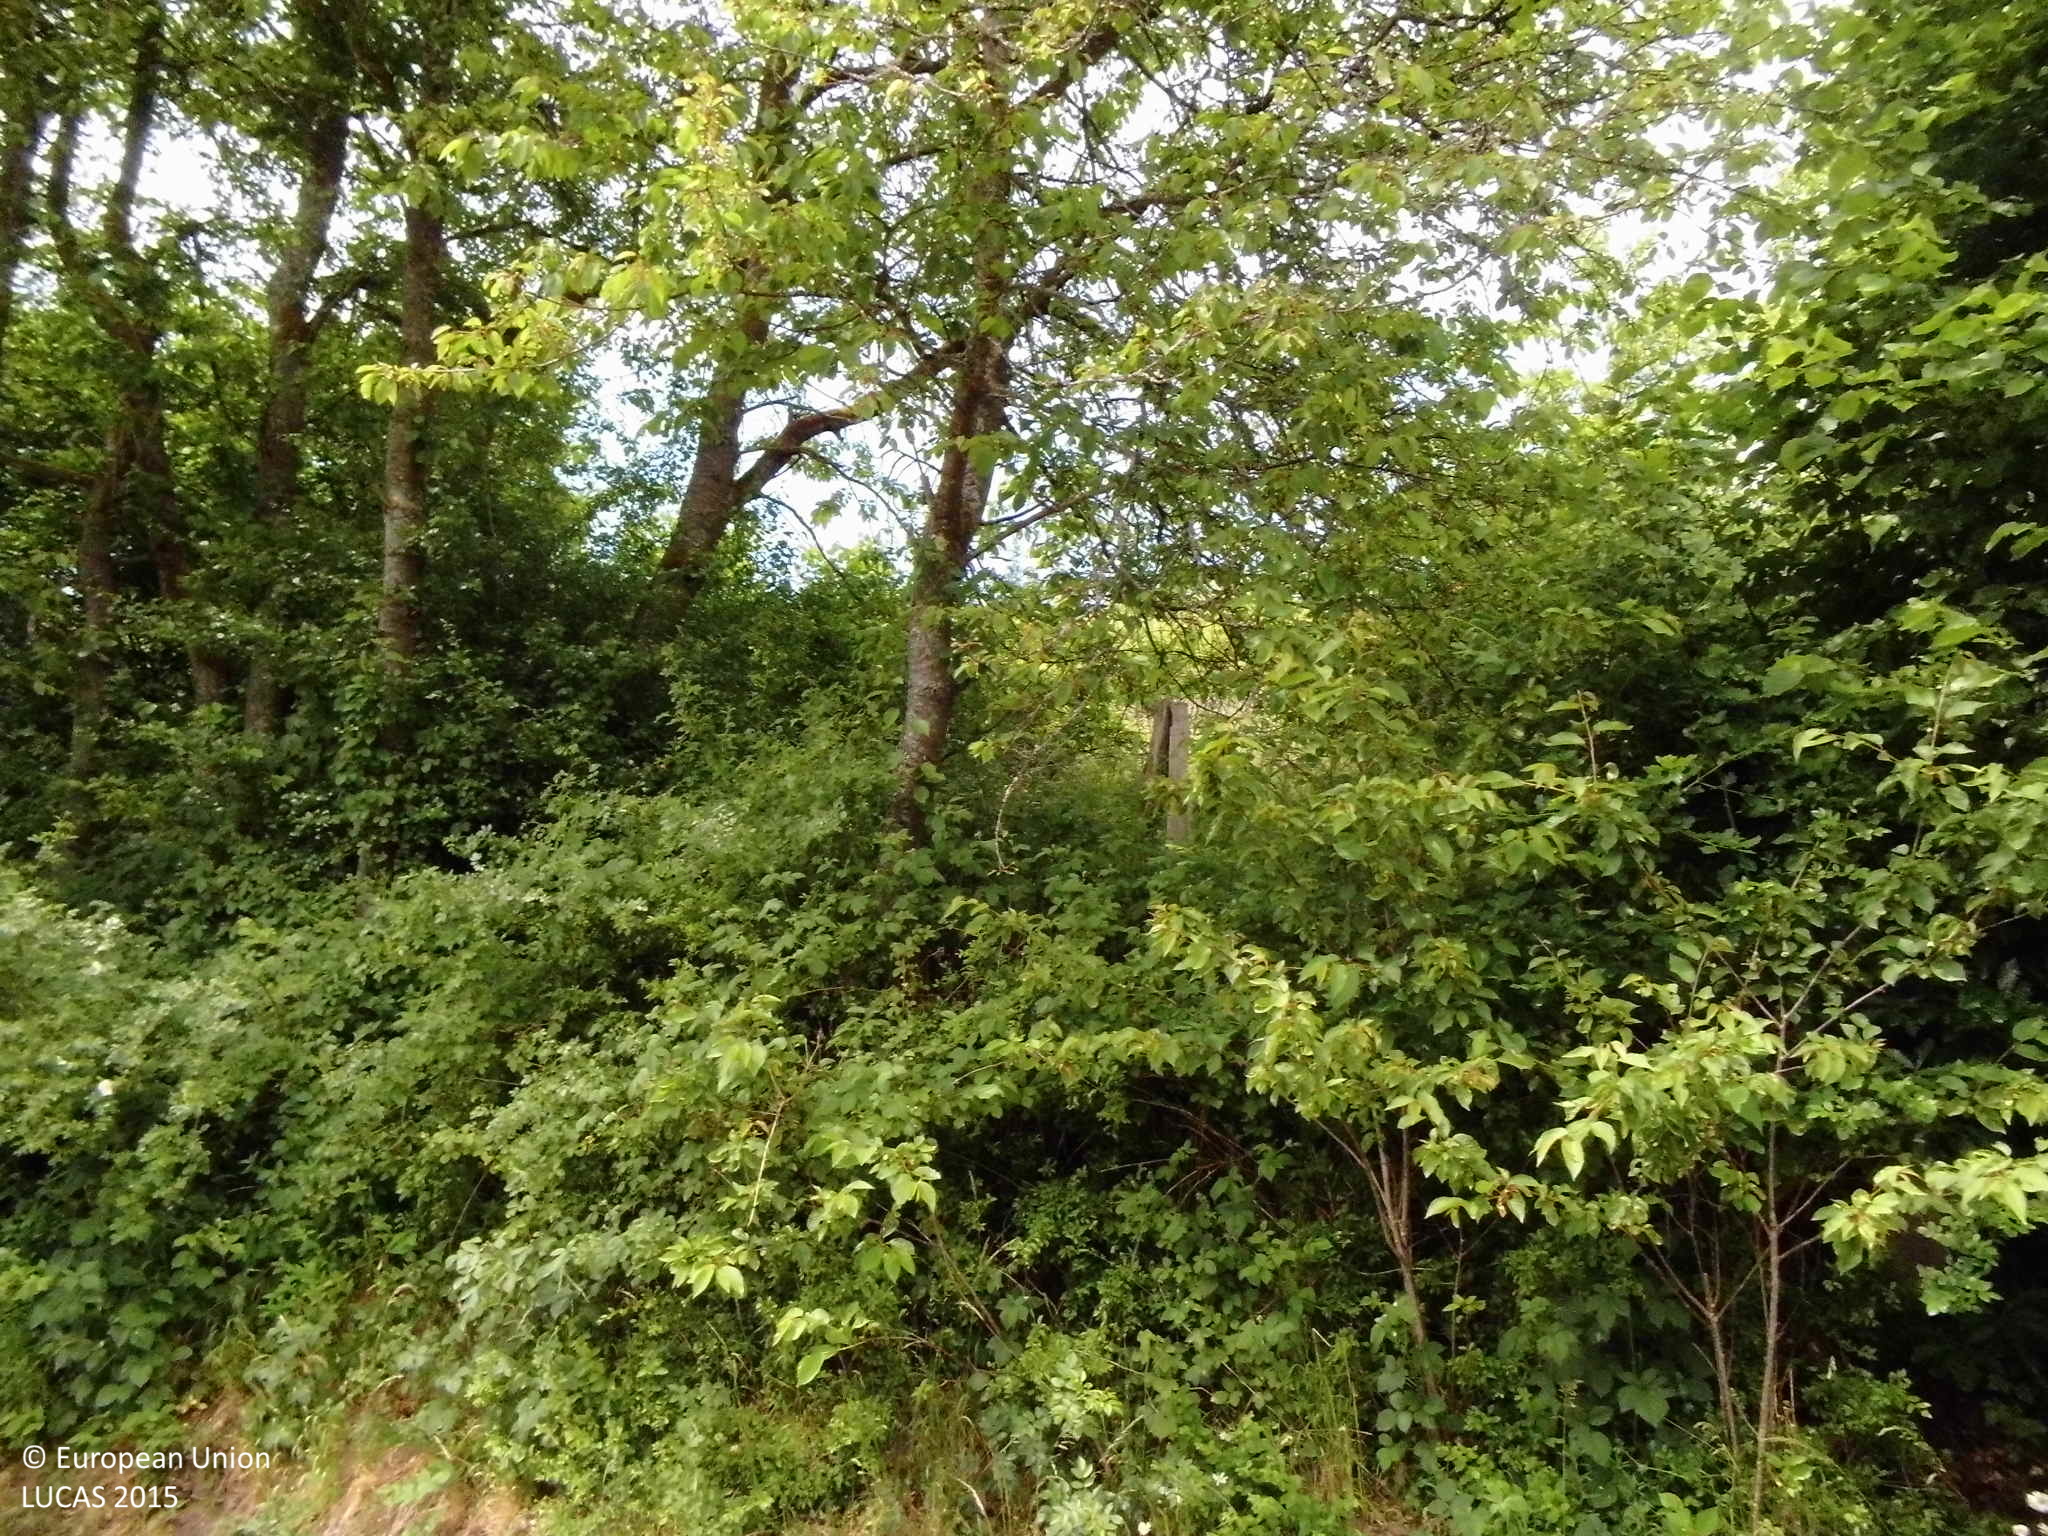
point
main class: Woodland
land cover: Broadleaved woodland
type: mesophytic deciduous forest
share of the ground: 50 - 75 %
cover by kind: broadleaved forest trees 60 %, herbaceous plants 30 %, shrubs 10 %
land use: Semi-natural and natural areas not in use
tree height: > 5 m
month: June
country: DE
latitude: 50.8762
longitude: 8.5365
